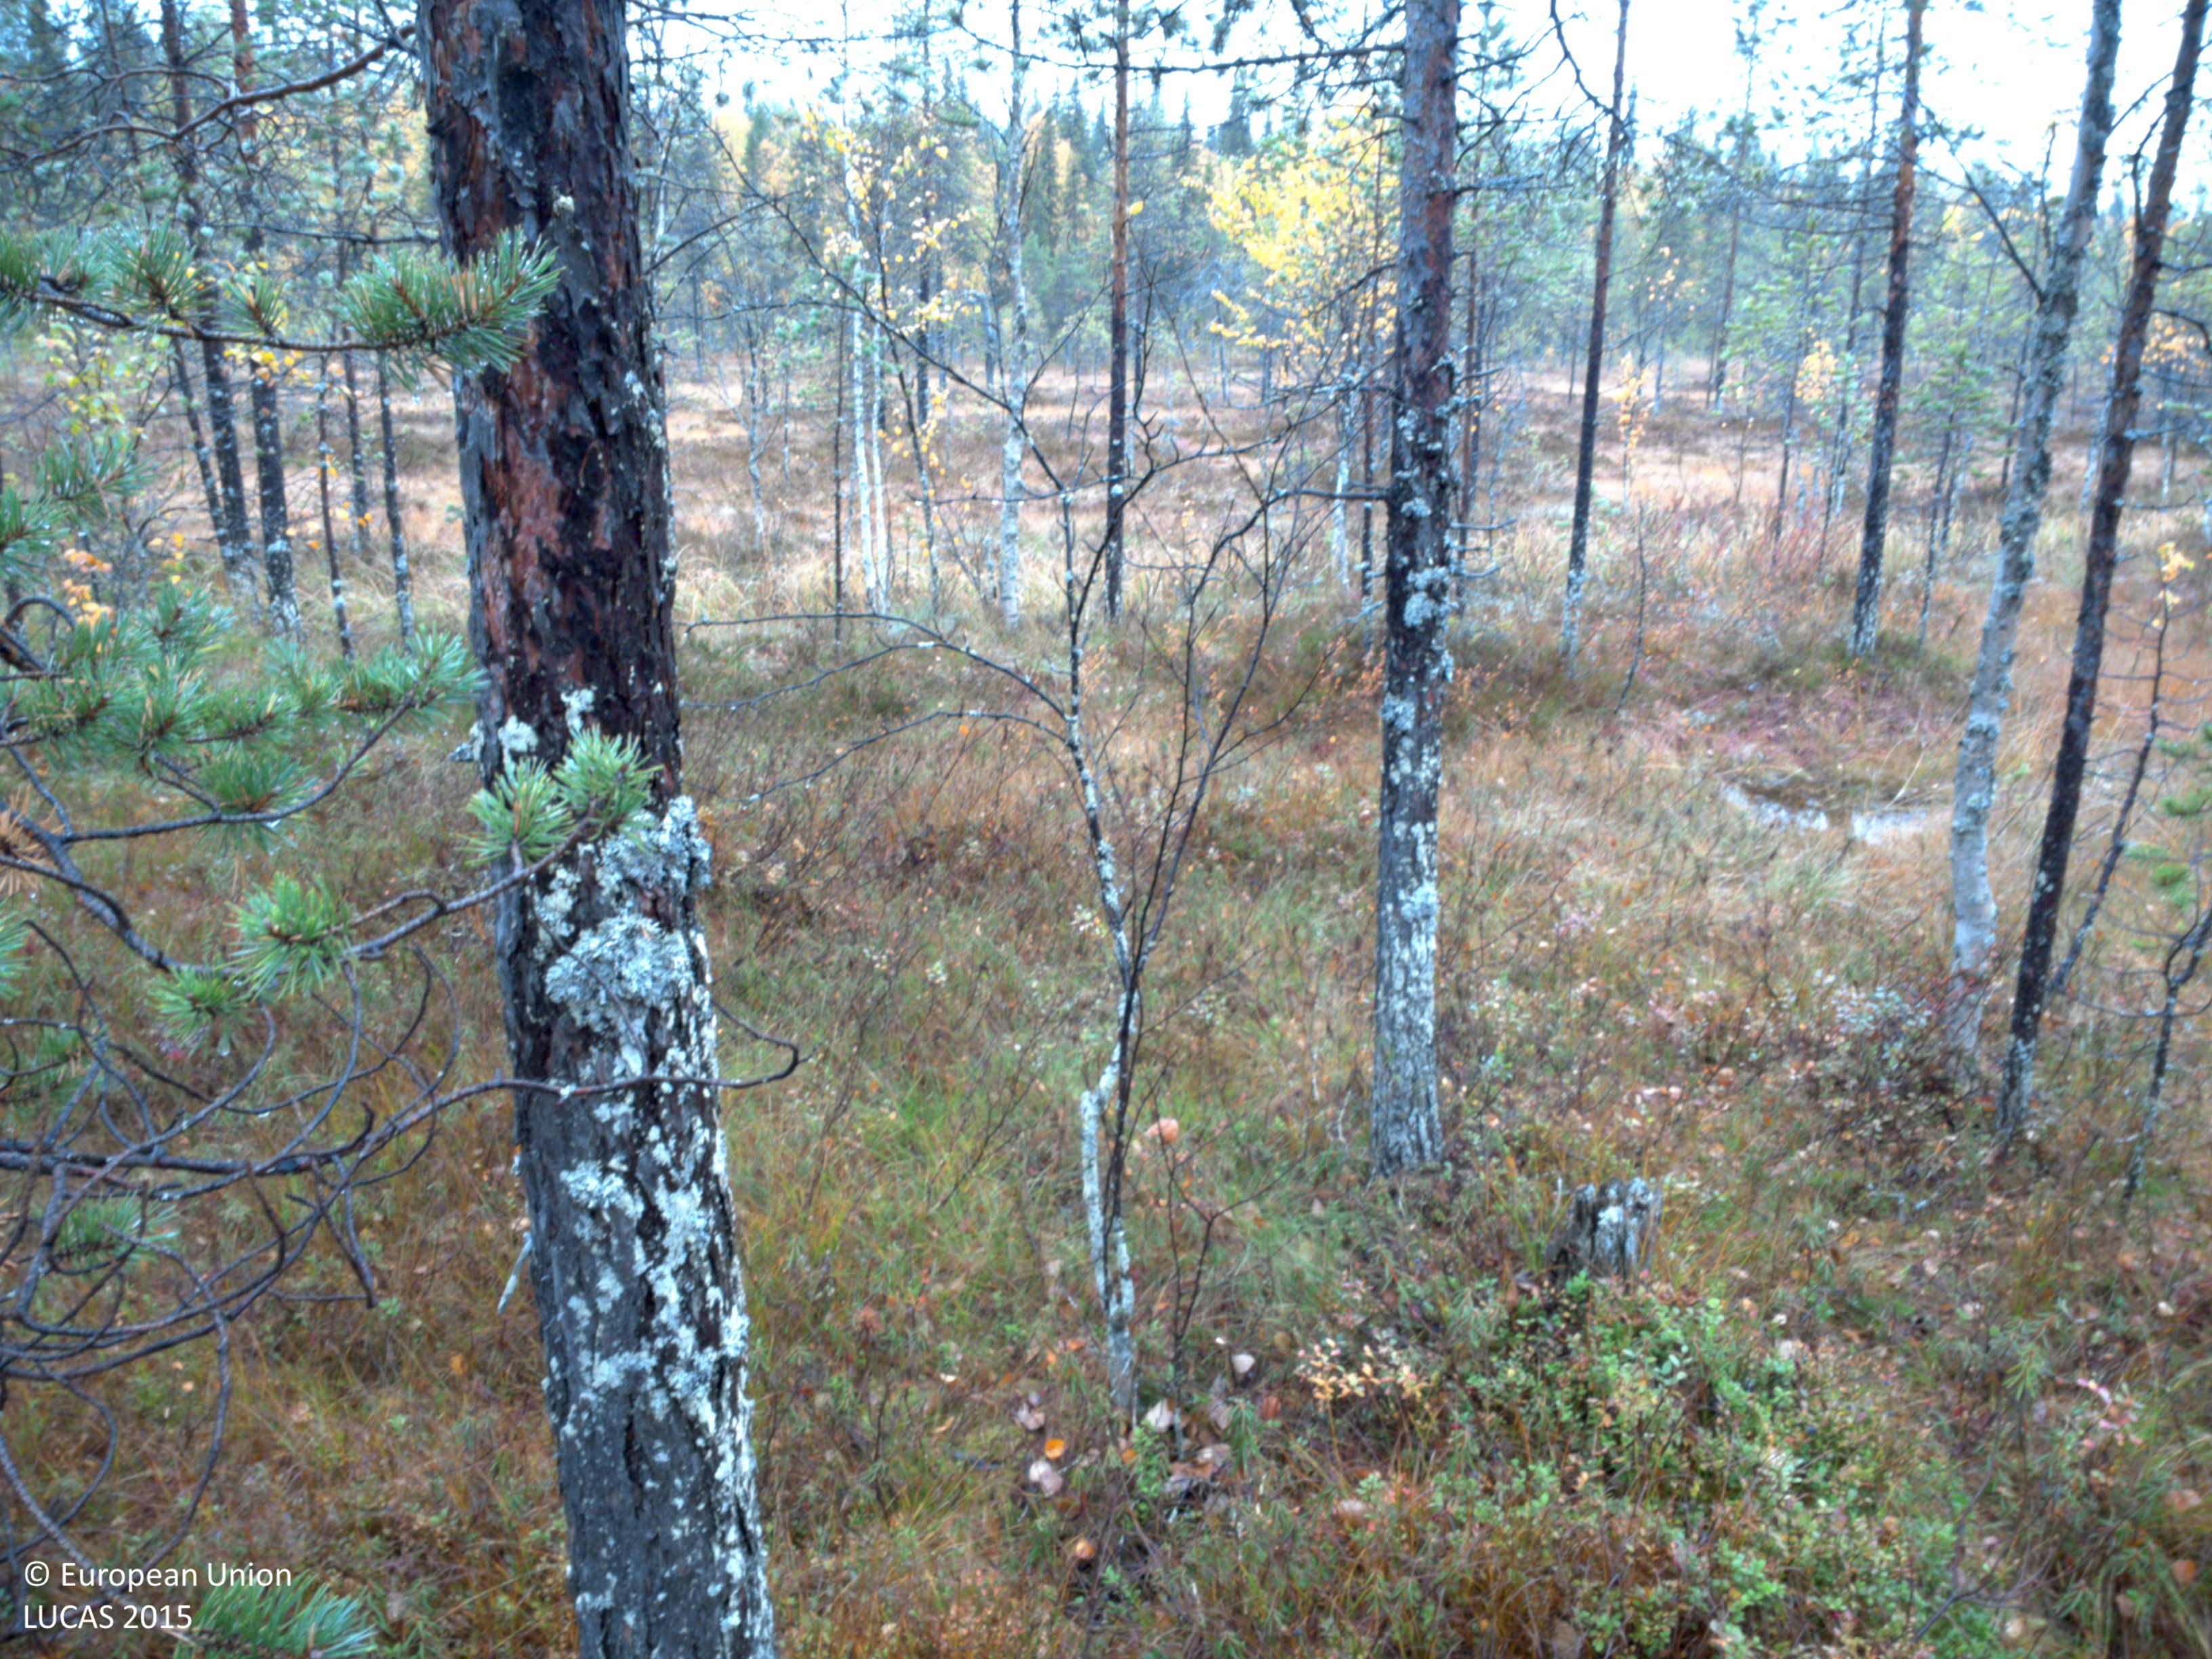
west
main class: Woodland
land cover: Pine dominated coniferous woodland
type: mire and swamp forests
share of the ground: 25 - 50 %
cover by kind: shrubs 35 %, coniferous forest trees 25 %, herbaceous plants 20 %, lichens and mosses 15 %, broadleaved forest trees 5 %
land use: Forestry
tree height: > 5 m
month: September
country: SE
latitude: 64.9718
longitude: 19.1389
